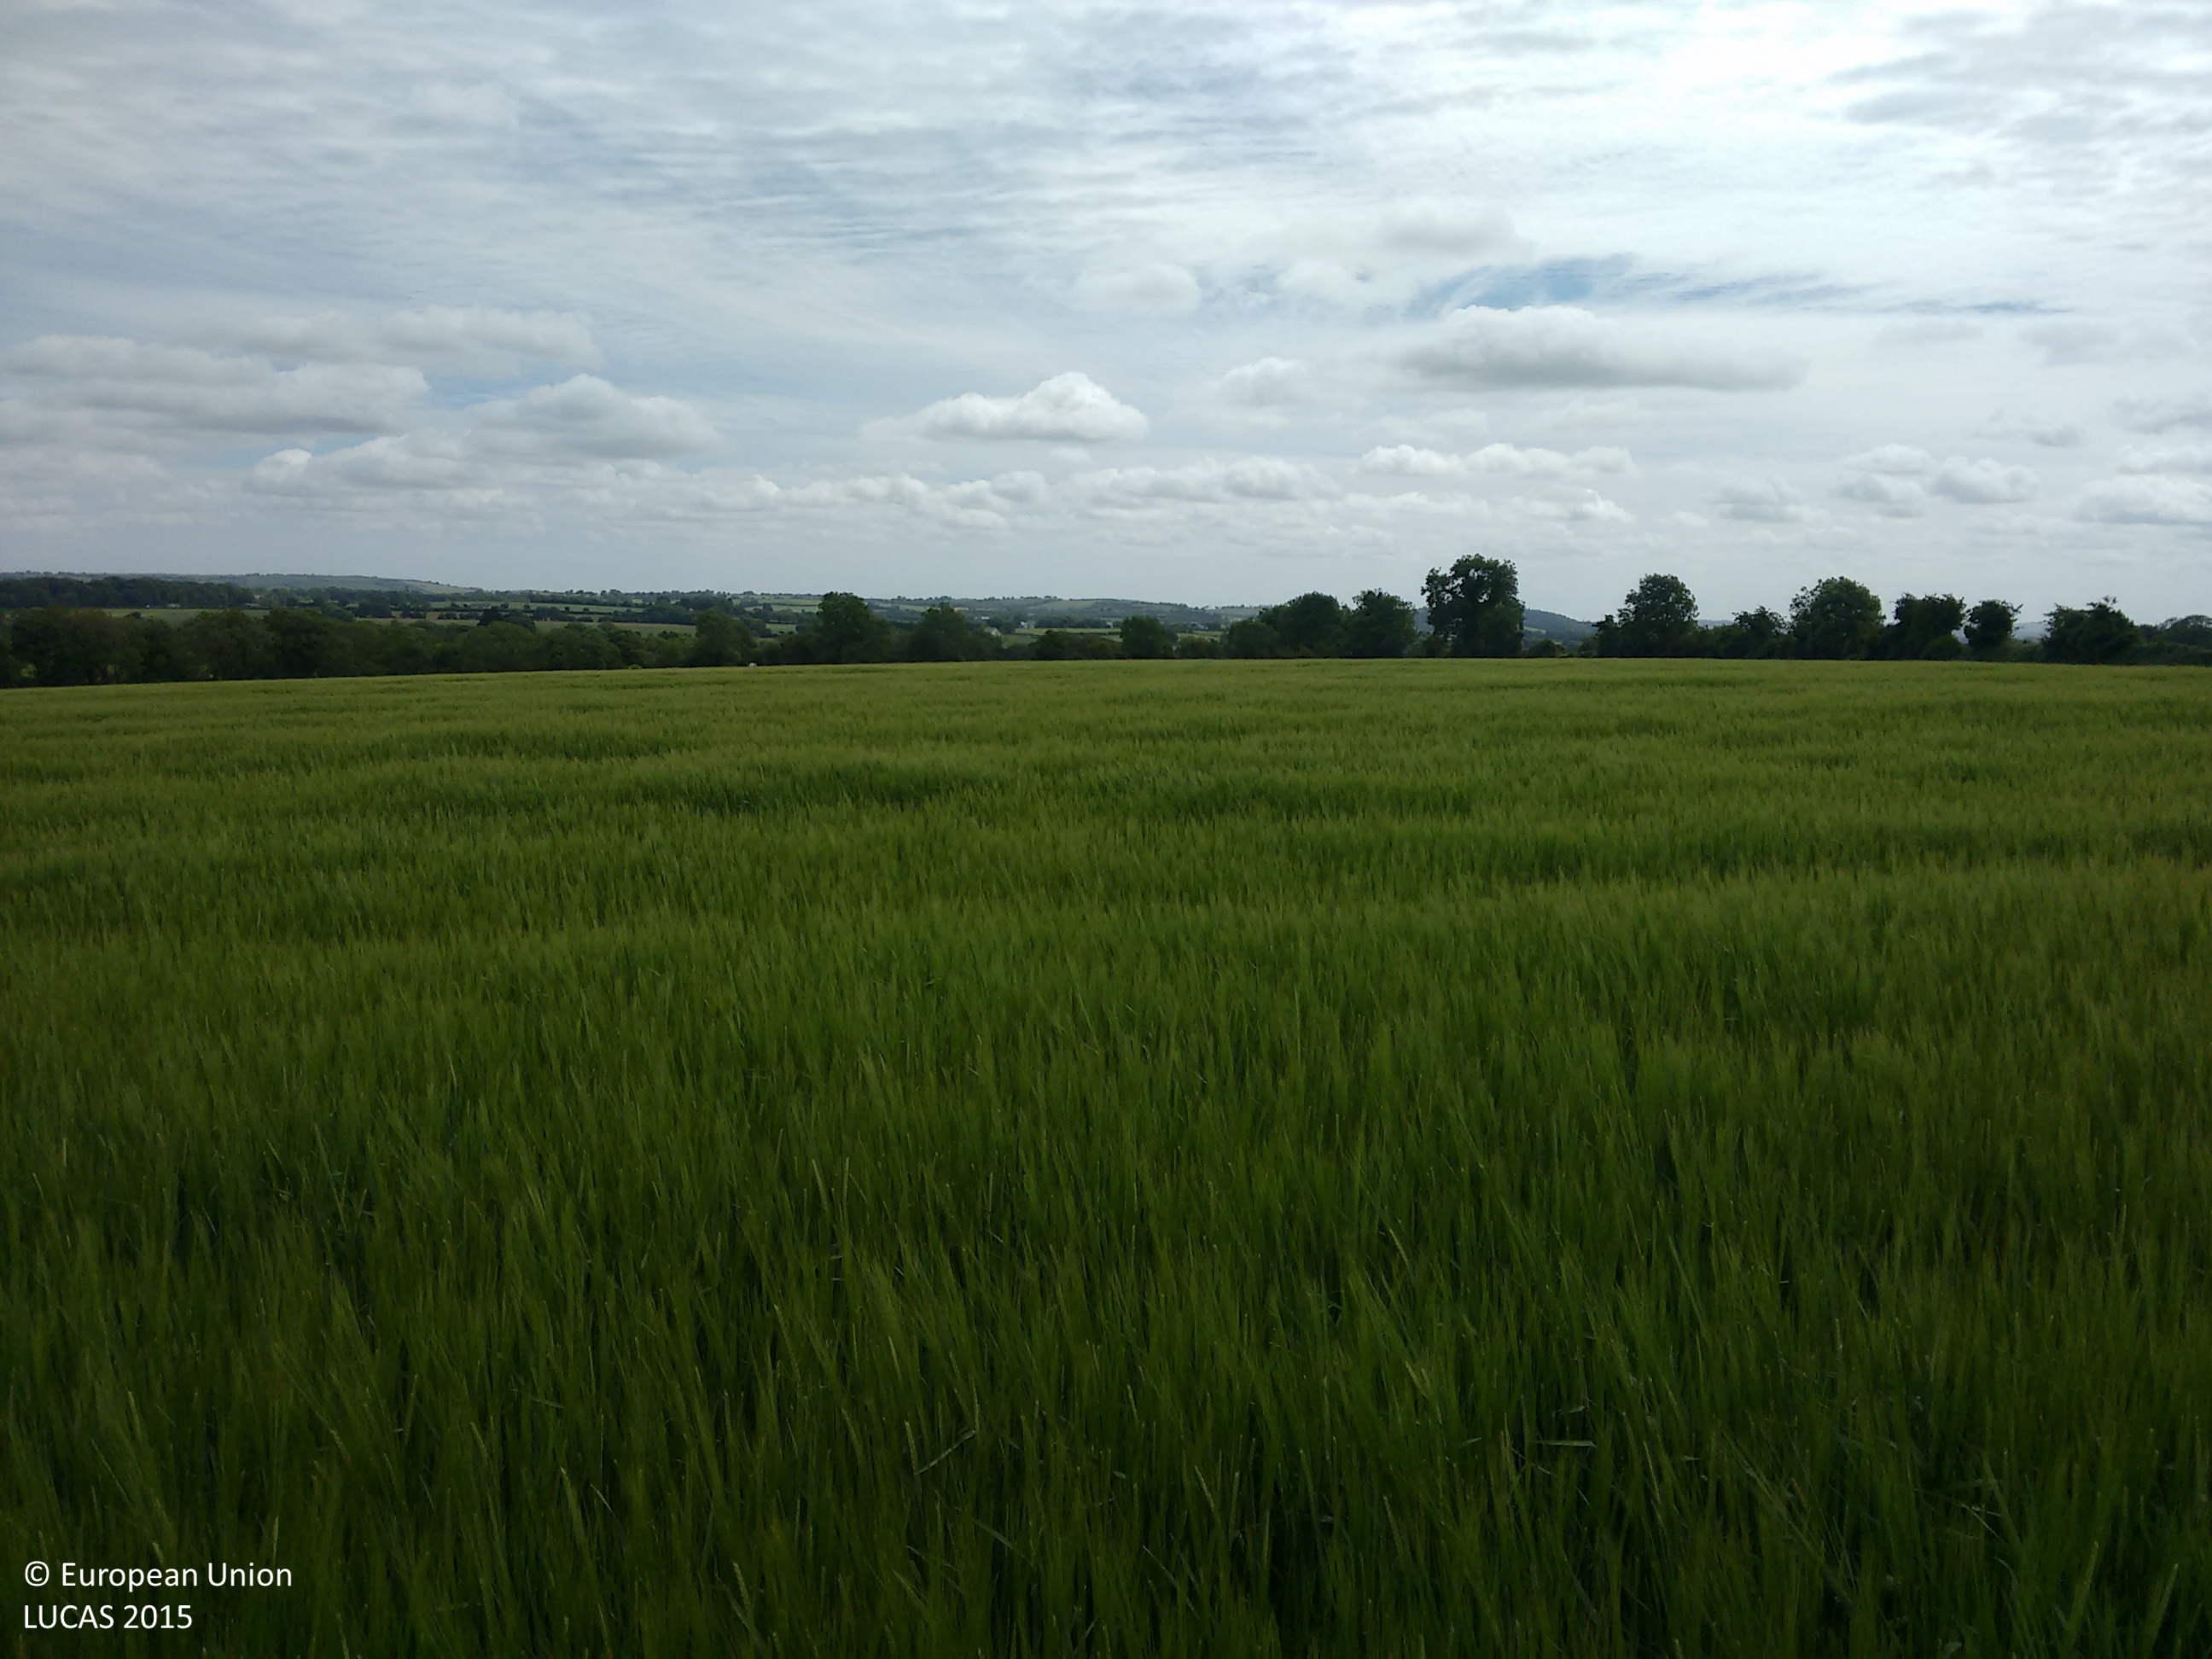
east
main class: Cropland
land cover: Barley
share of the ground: > 75 %
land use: Agriculture (excluding fallow land and kitchen gardens)
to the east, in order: Barley
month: June
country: IE
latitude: 53.7285
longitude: -6.6364
